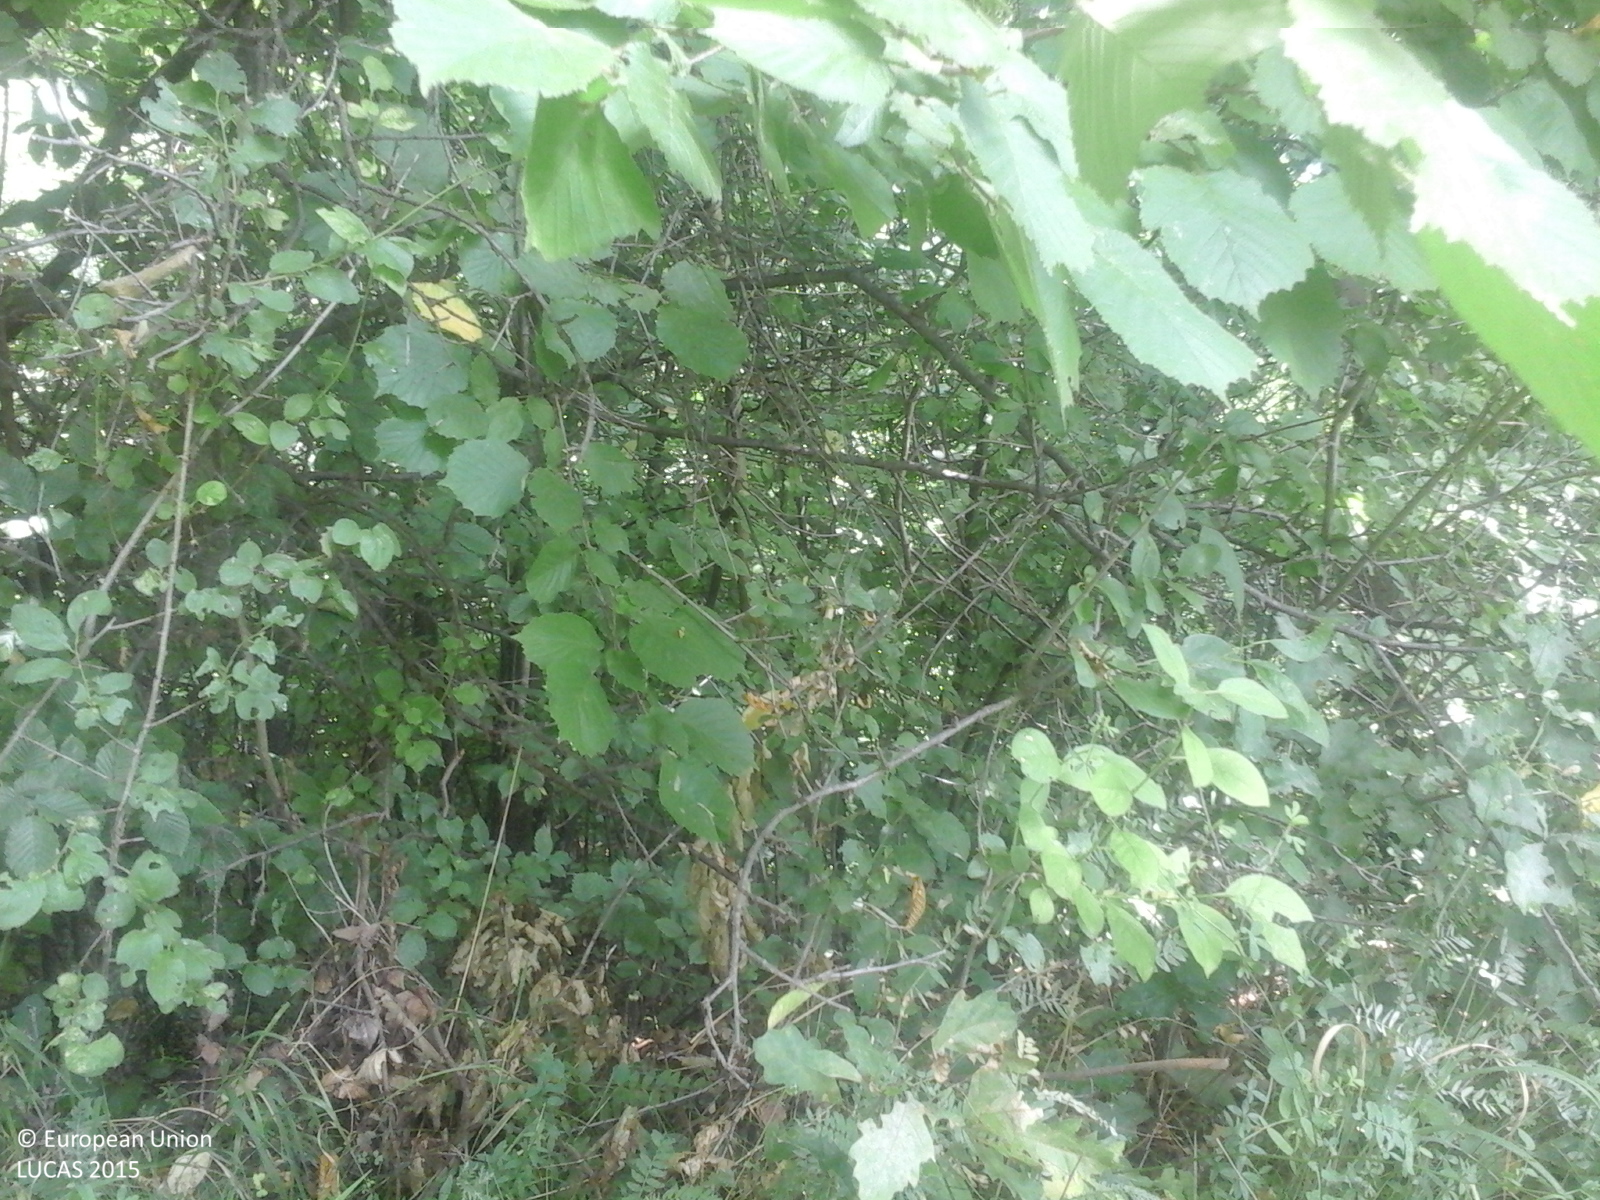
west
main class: Woodland
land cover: Broadleaved woodland
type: beech forest
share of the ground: > 75 %
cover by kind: broadleaved forest trees 100 %
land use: Forestry
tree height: > 5 m
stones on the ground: < 10 %
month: July
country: RO
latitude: 45.1889
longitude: 24.6533
